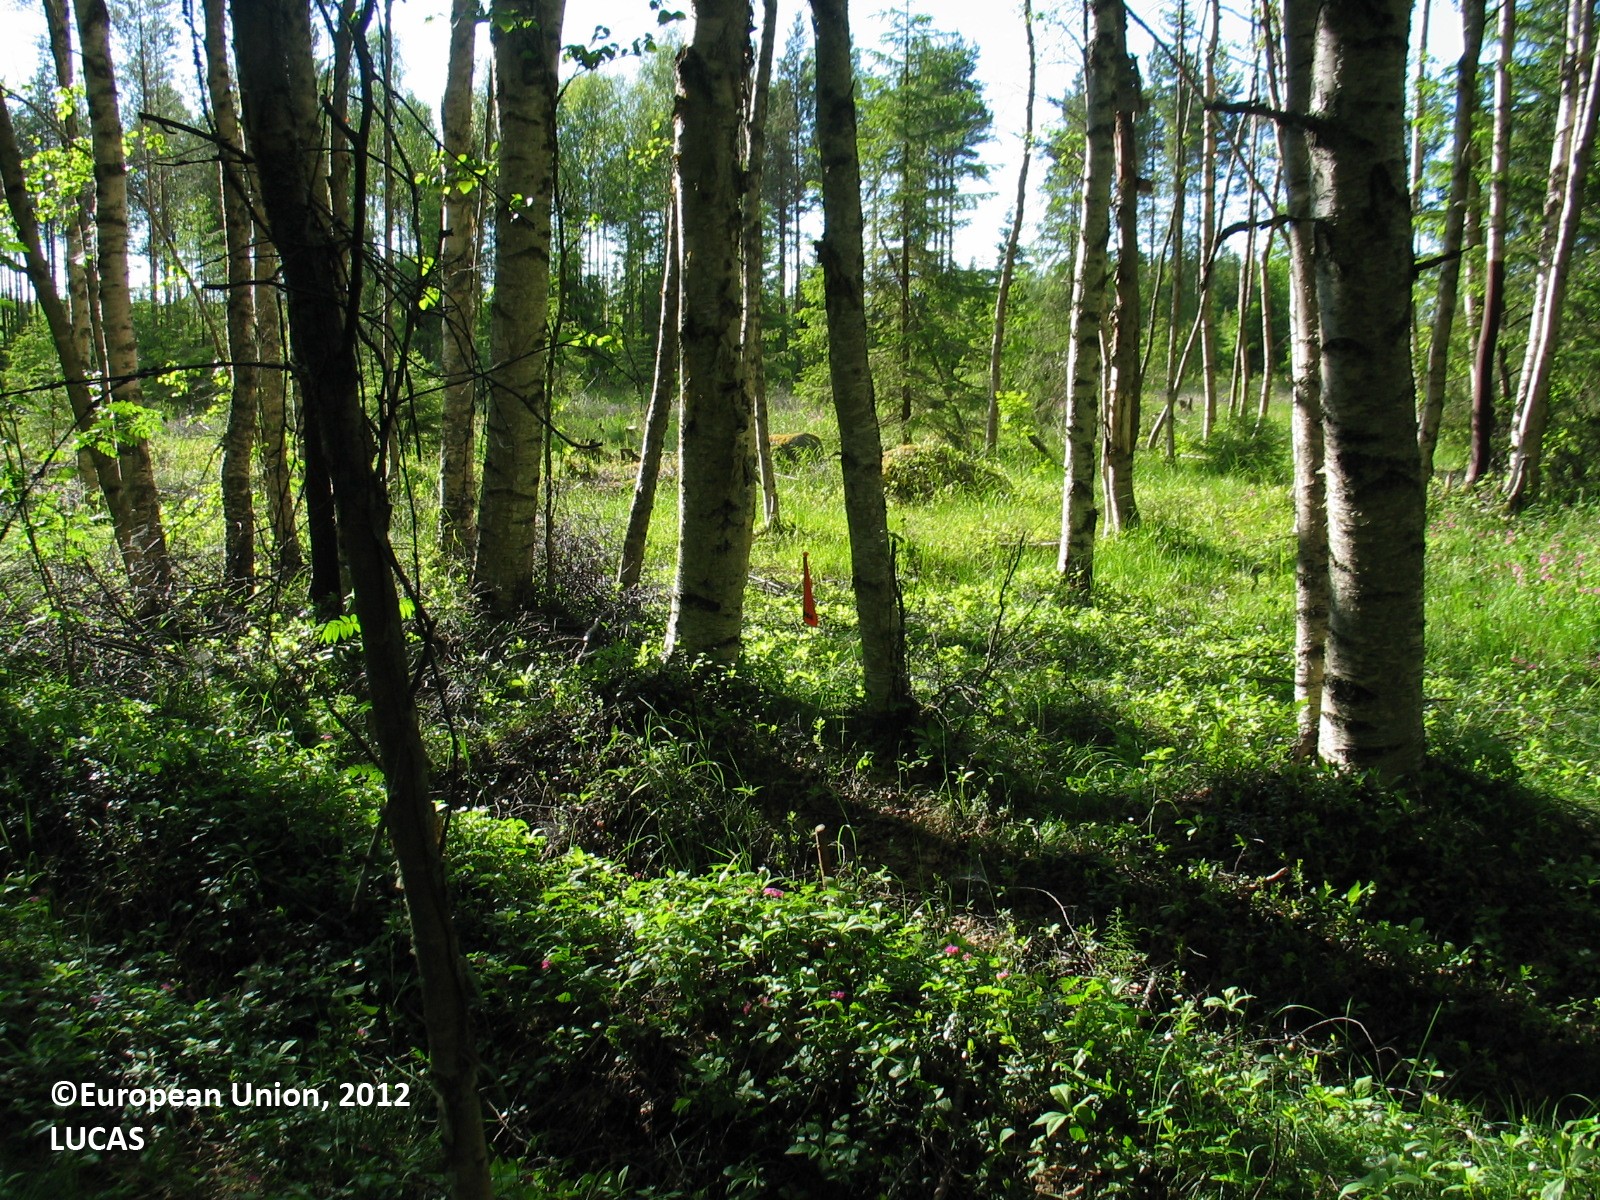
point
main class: Woodland
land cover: Broadleaved woodland
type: boreal forest
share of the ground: 50 - 75 %
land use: Forestry
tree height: > 5 m
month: June
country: FI
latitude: 65.1545
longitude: 25.4162
